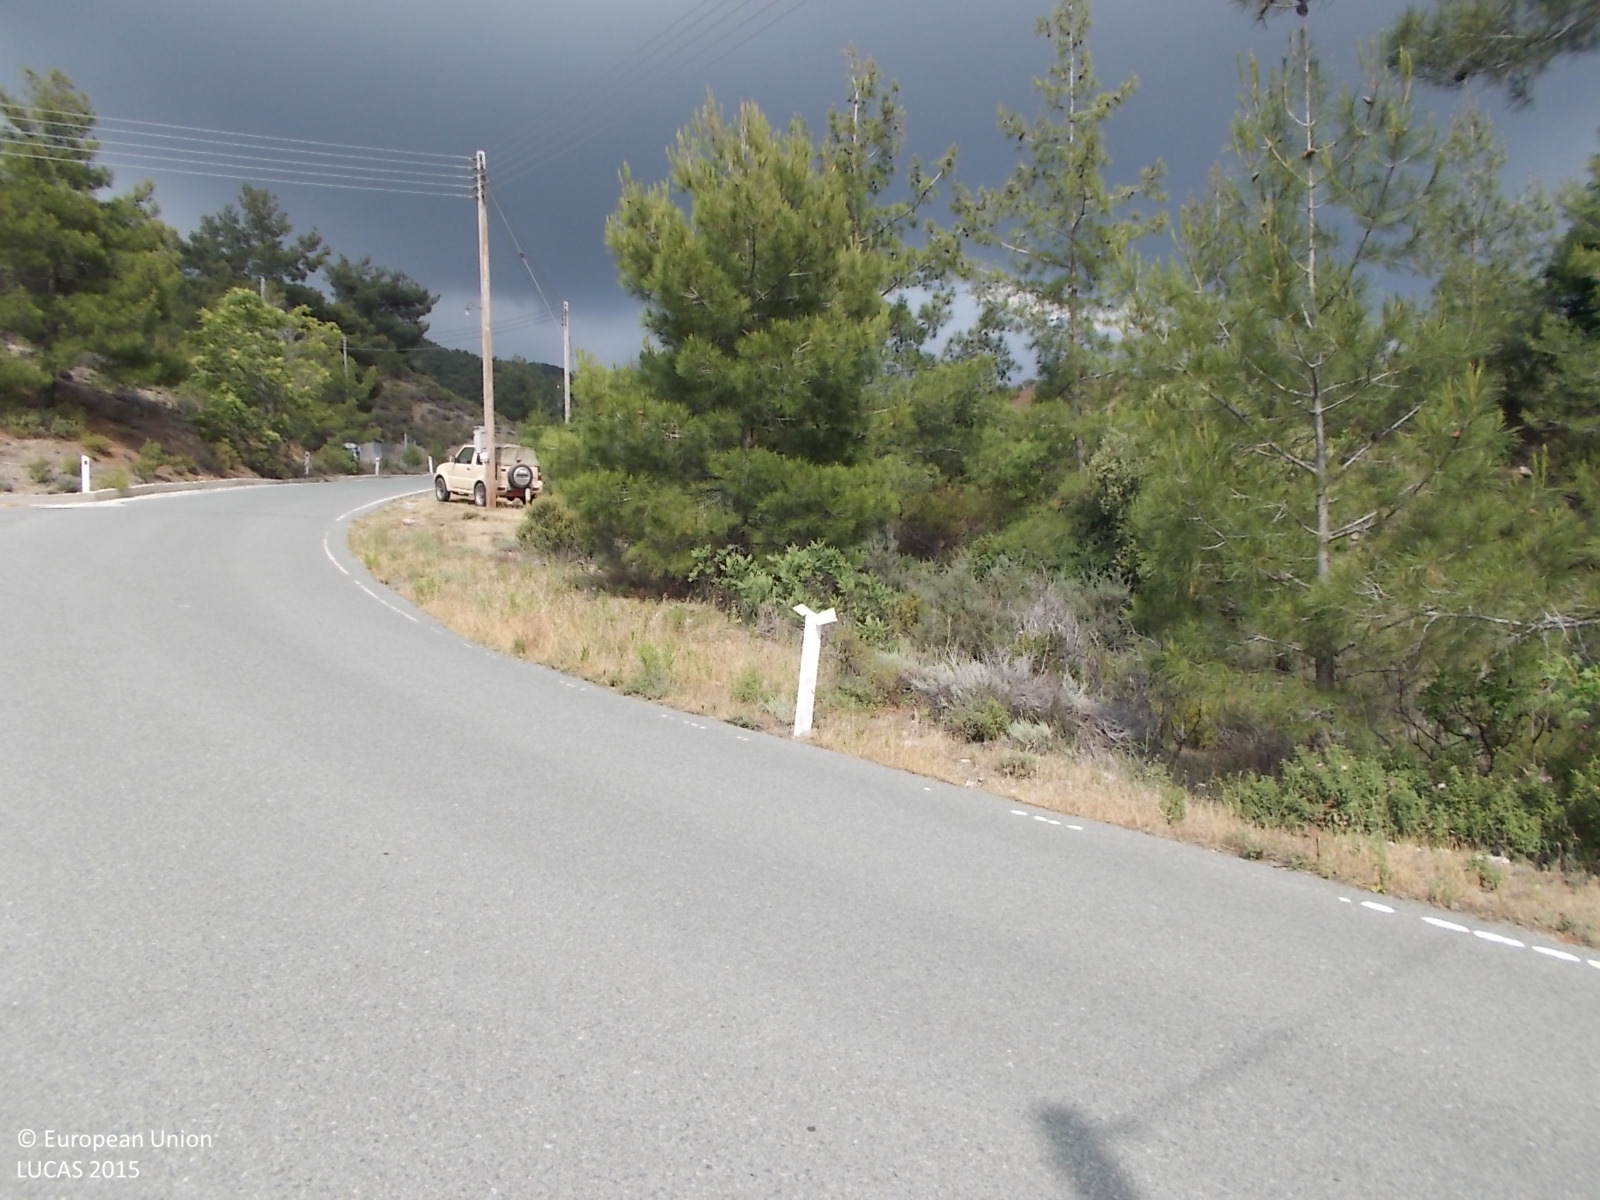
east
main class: Shrubland
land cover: Shrubland with sparse tree cover
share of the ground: 25 - 50 %
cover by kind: unconsolidated bare surface 50 %, shrubs 45 %, coniferous forest trees 5 %
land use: Semi-natural and natural areas not in use
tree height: > 5 m
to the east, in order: Shrubland with sparse tree cover; Paved roads, cycling and walking lanes; Electric lines; Pine dominated coniferous woodland; Spontaneously vegetated surfaces; Shrubland without tree cover; Fences; Nuts trees; Other fruit trees and berries; Fences; Tracks; Pine dominated coniferous woodland
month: June
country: CY
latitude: 34.8892
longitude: 32.8471
